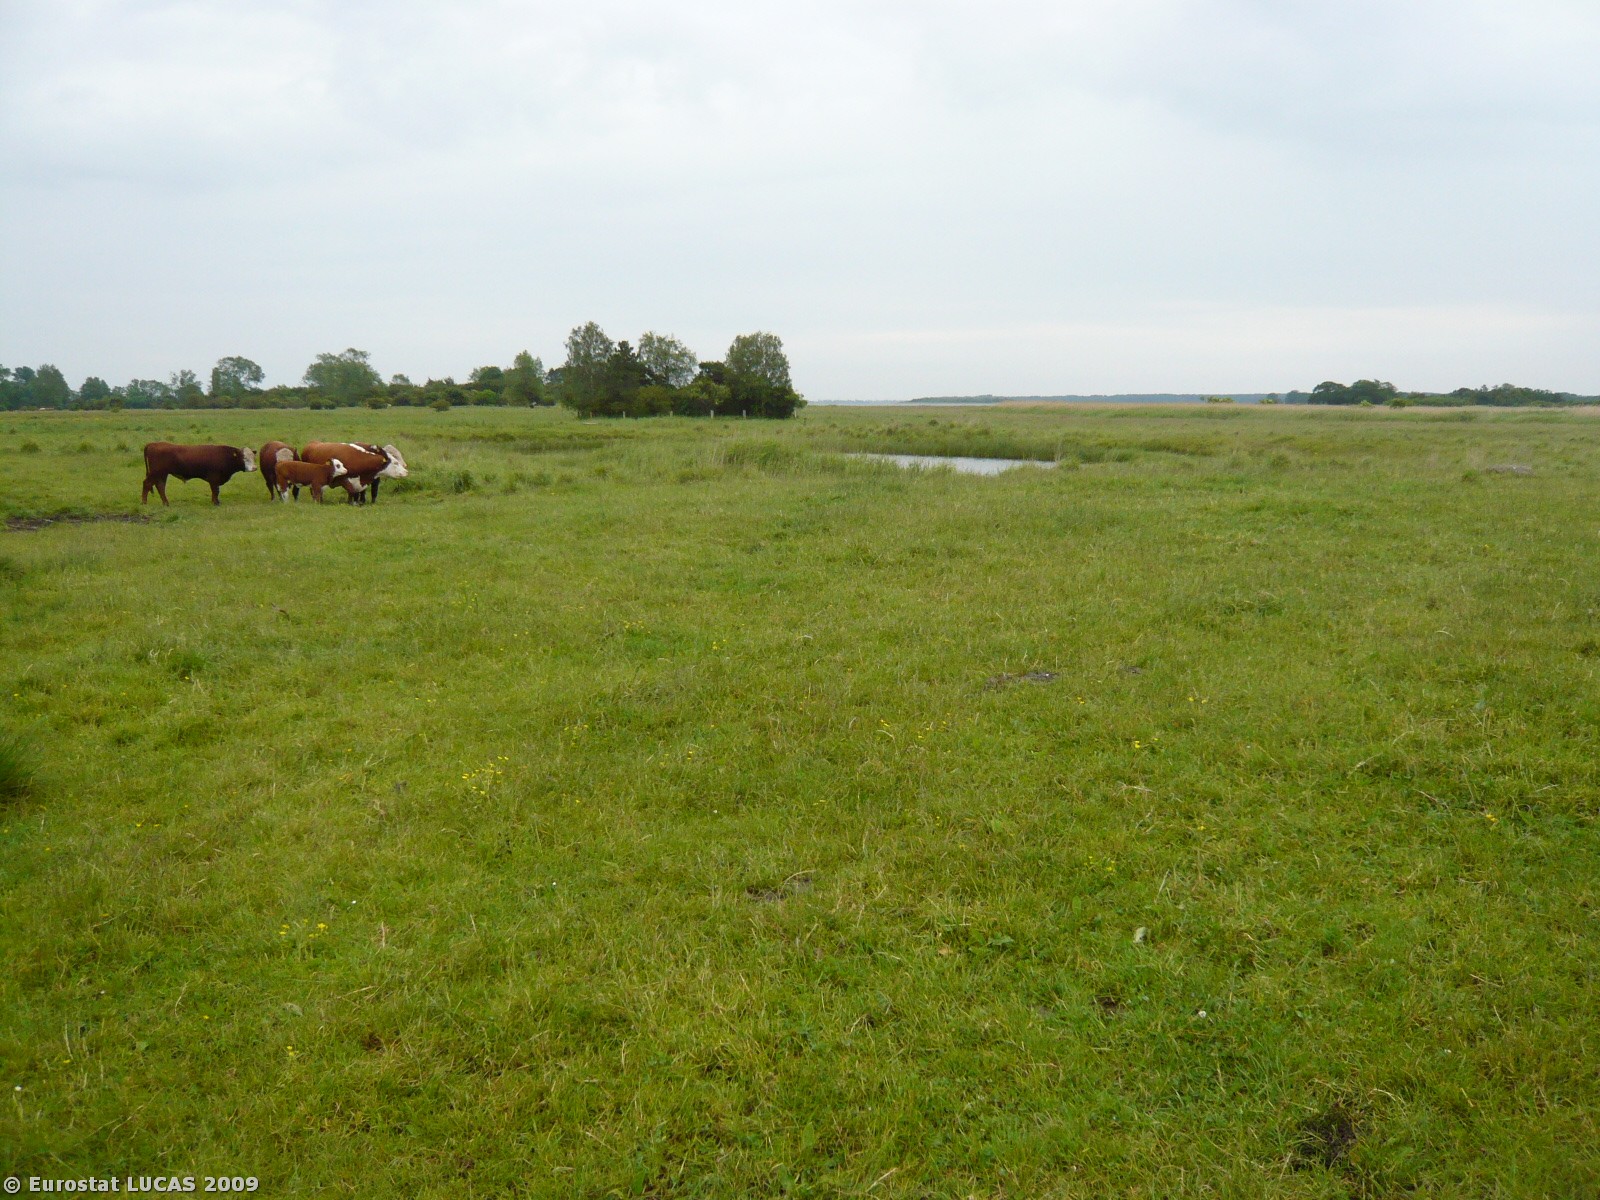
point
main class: Grassland
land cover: Grassland without tree/shrub cover
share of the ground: > 75 %
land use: Agriculture (excluding fallow land and kitchen gardens)
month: June
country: DK
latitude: 54.7366
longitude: 11.8160
